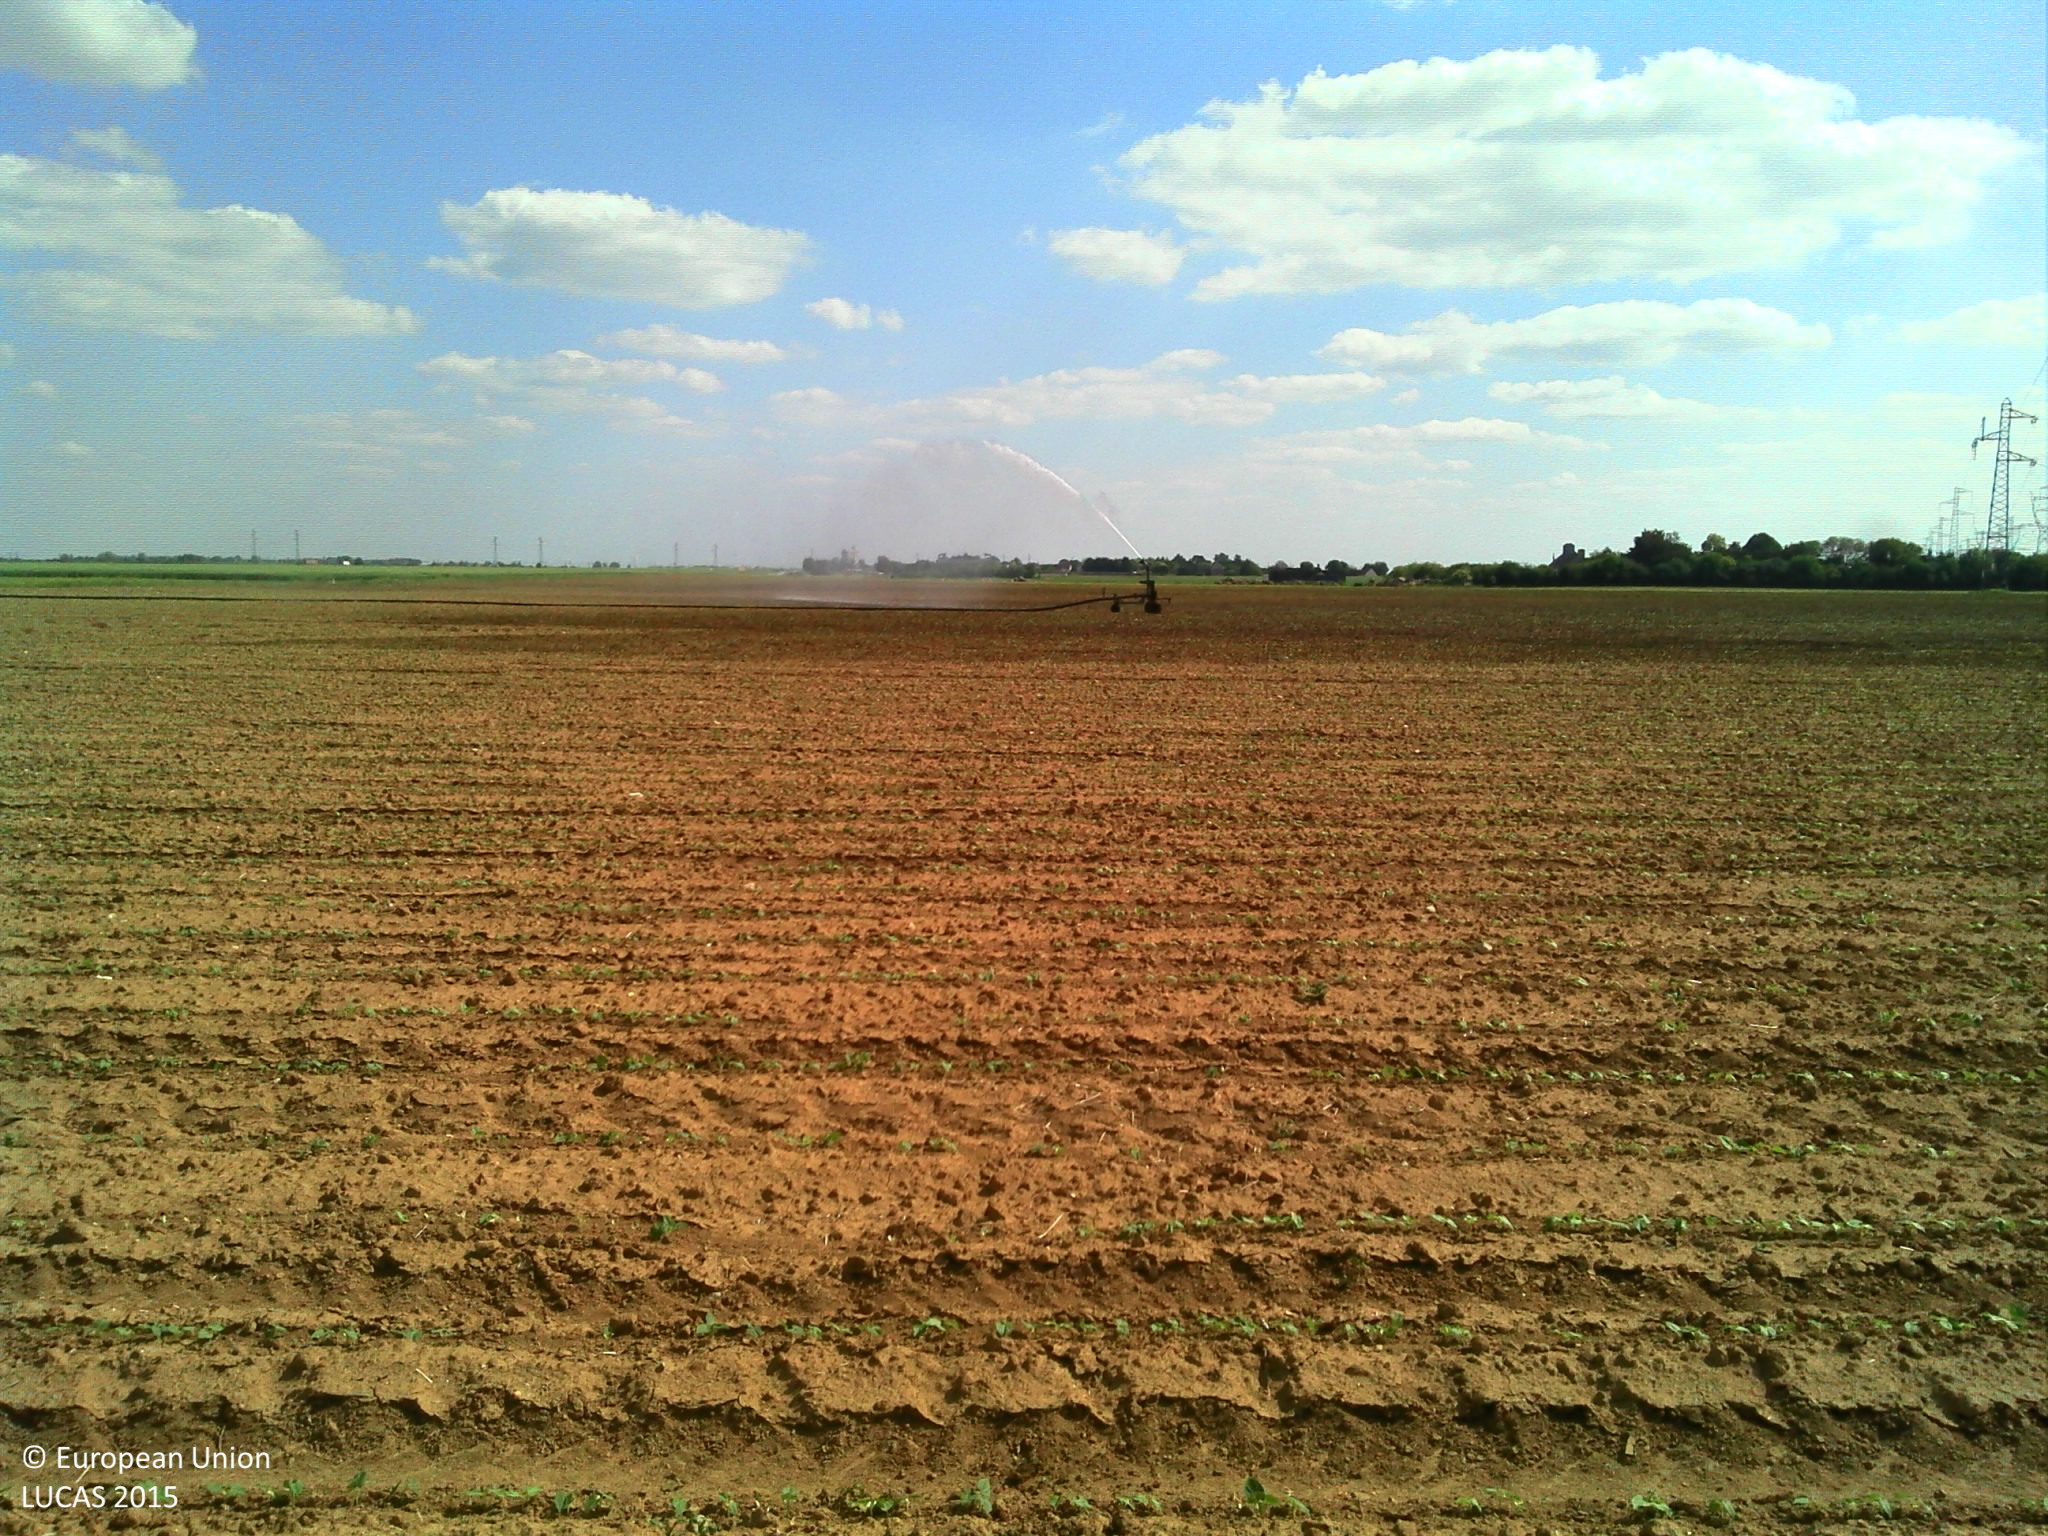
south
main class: Cropland
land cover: Dry pulses
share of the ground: 25 - 50 %
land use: Agriculture (excluding fallow land and kitchen gardens)
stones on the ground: < 10 %
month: May
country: FR
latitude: 48.2917
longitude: 1.9670
